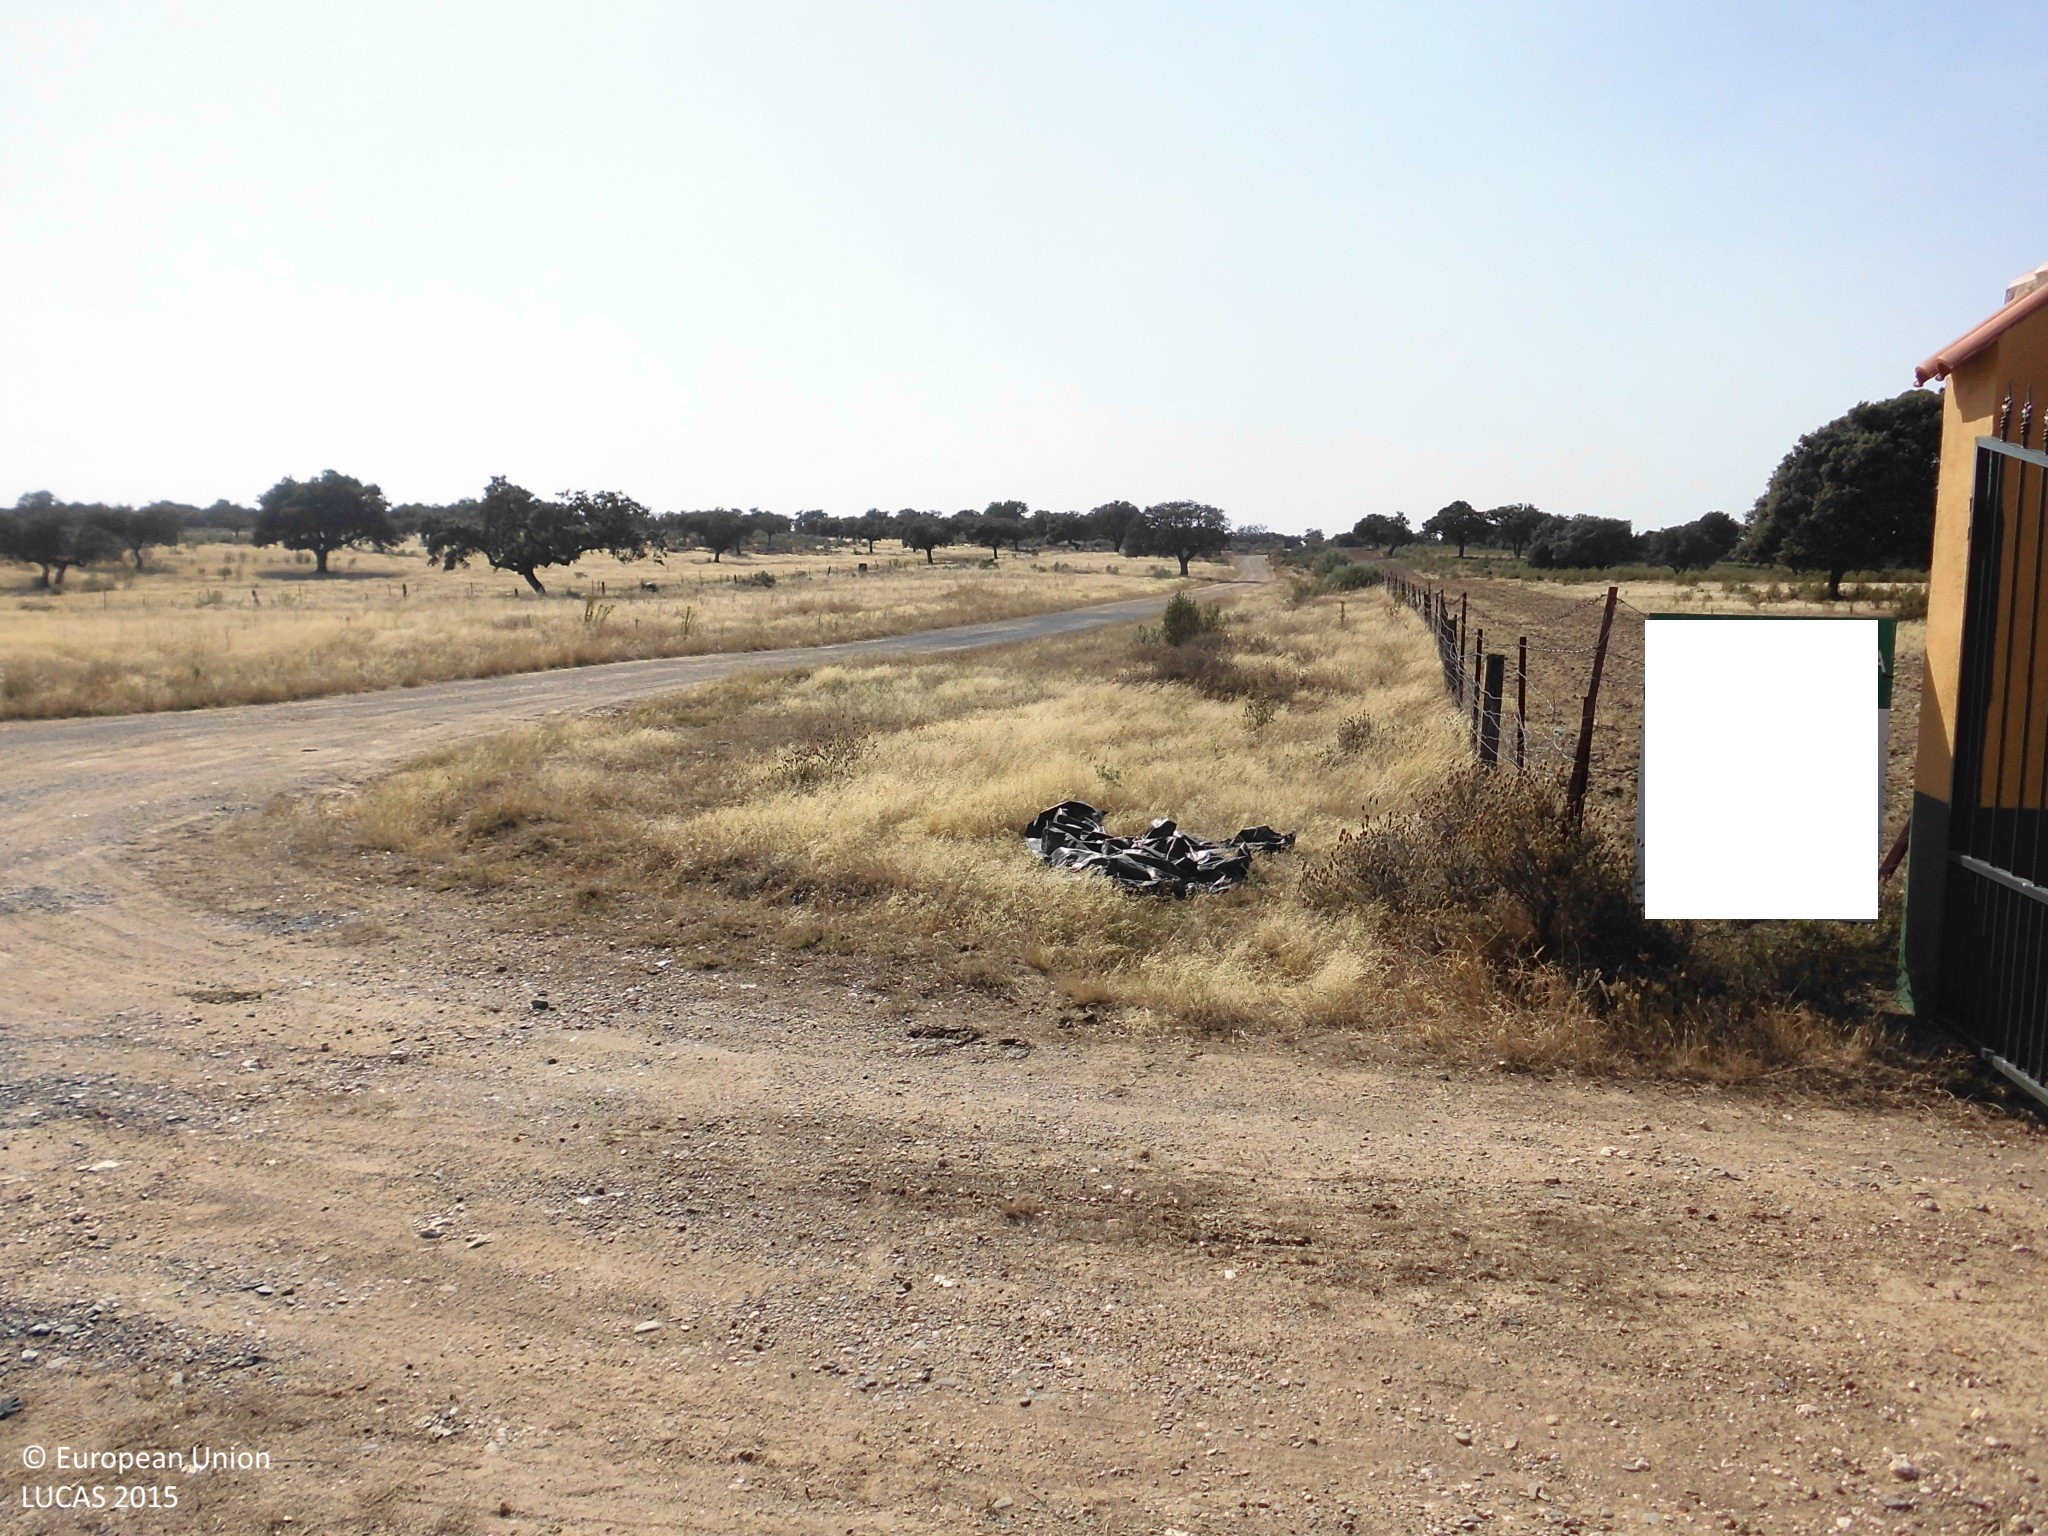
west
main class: Woodland
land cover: Broadleaved woodland
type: broadleaved evergreen forest
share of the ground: 25 - 50 %
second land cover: Shrubland without tree cover
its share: > 75 %
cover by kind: herbaceous plants 50 %, broadleaved forest trees 25 %, shrubs 25 %
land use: Forestry
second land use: Agriculture (excluding fallow land and kitchen gardens)
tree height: > 5 m
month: June
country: ES
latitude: 39.9314
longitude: -6.0416
